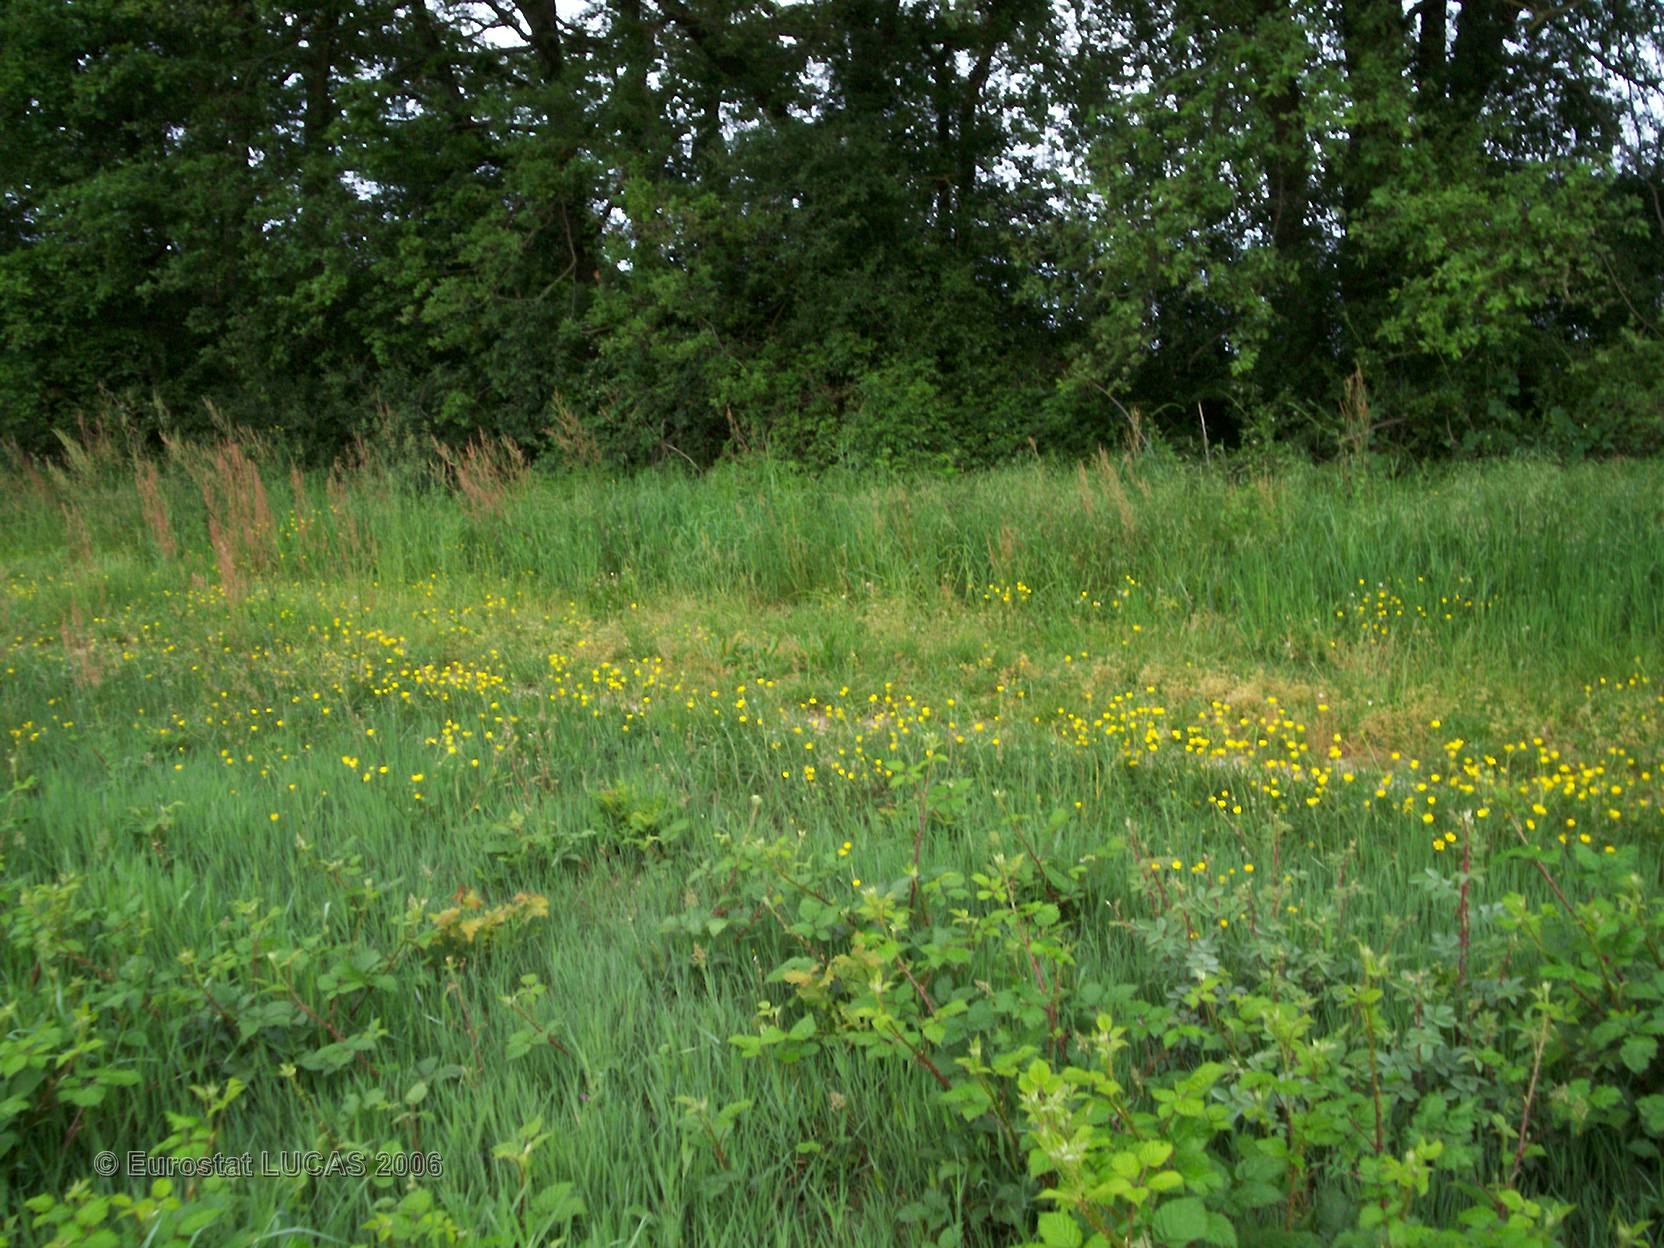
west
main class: Grassland
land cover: Grassland without tree/shrub cover
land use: Agriculture (excluding fallow land and kitchen gardens)
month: May
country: FR
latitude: 46.8945
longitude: 0.9939
